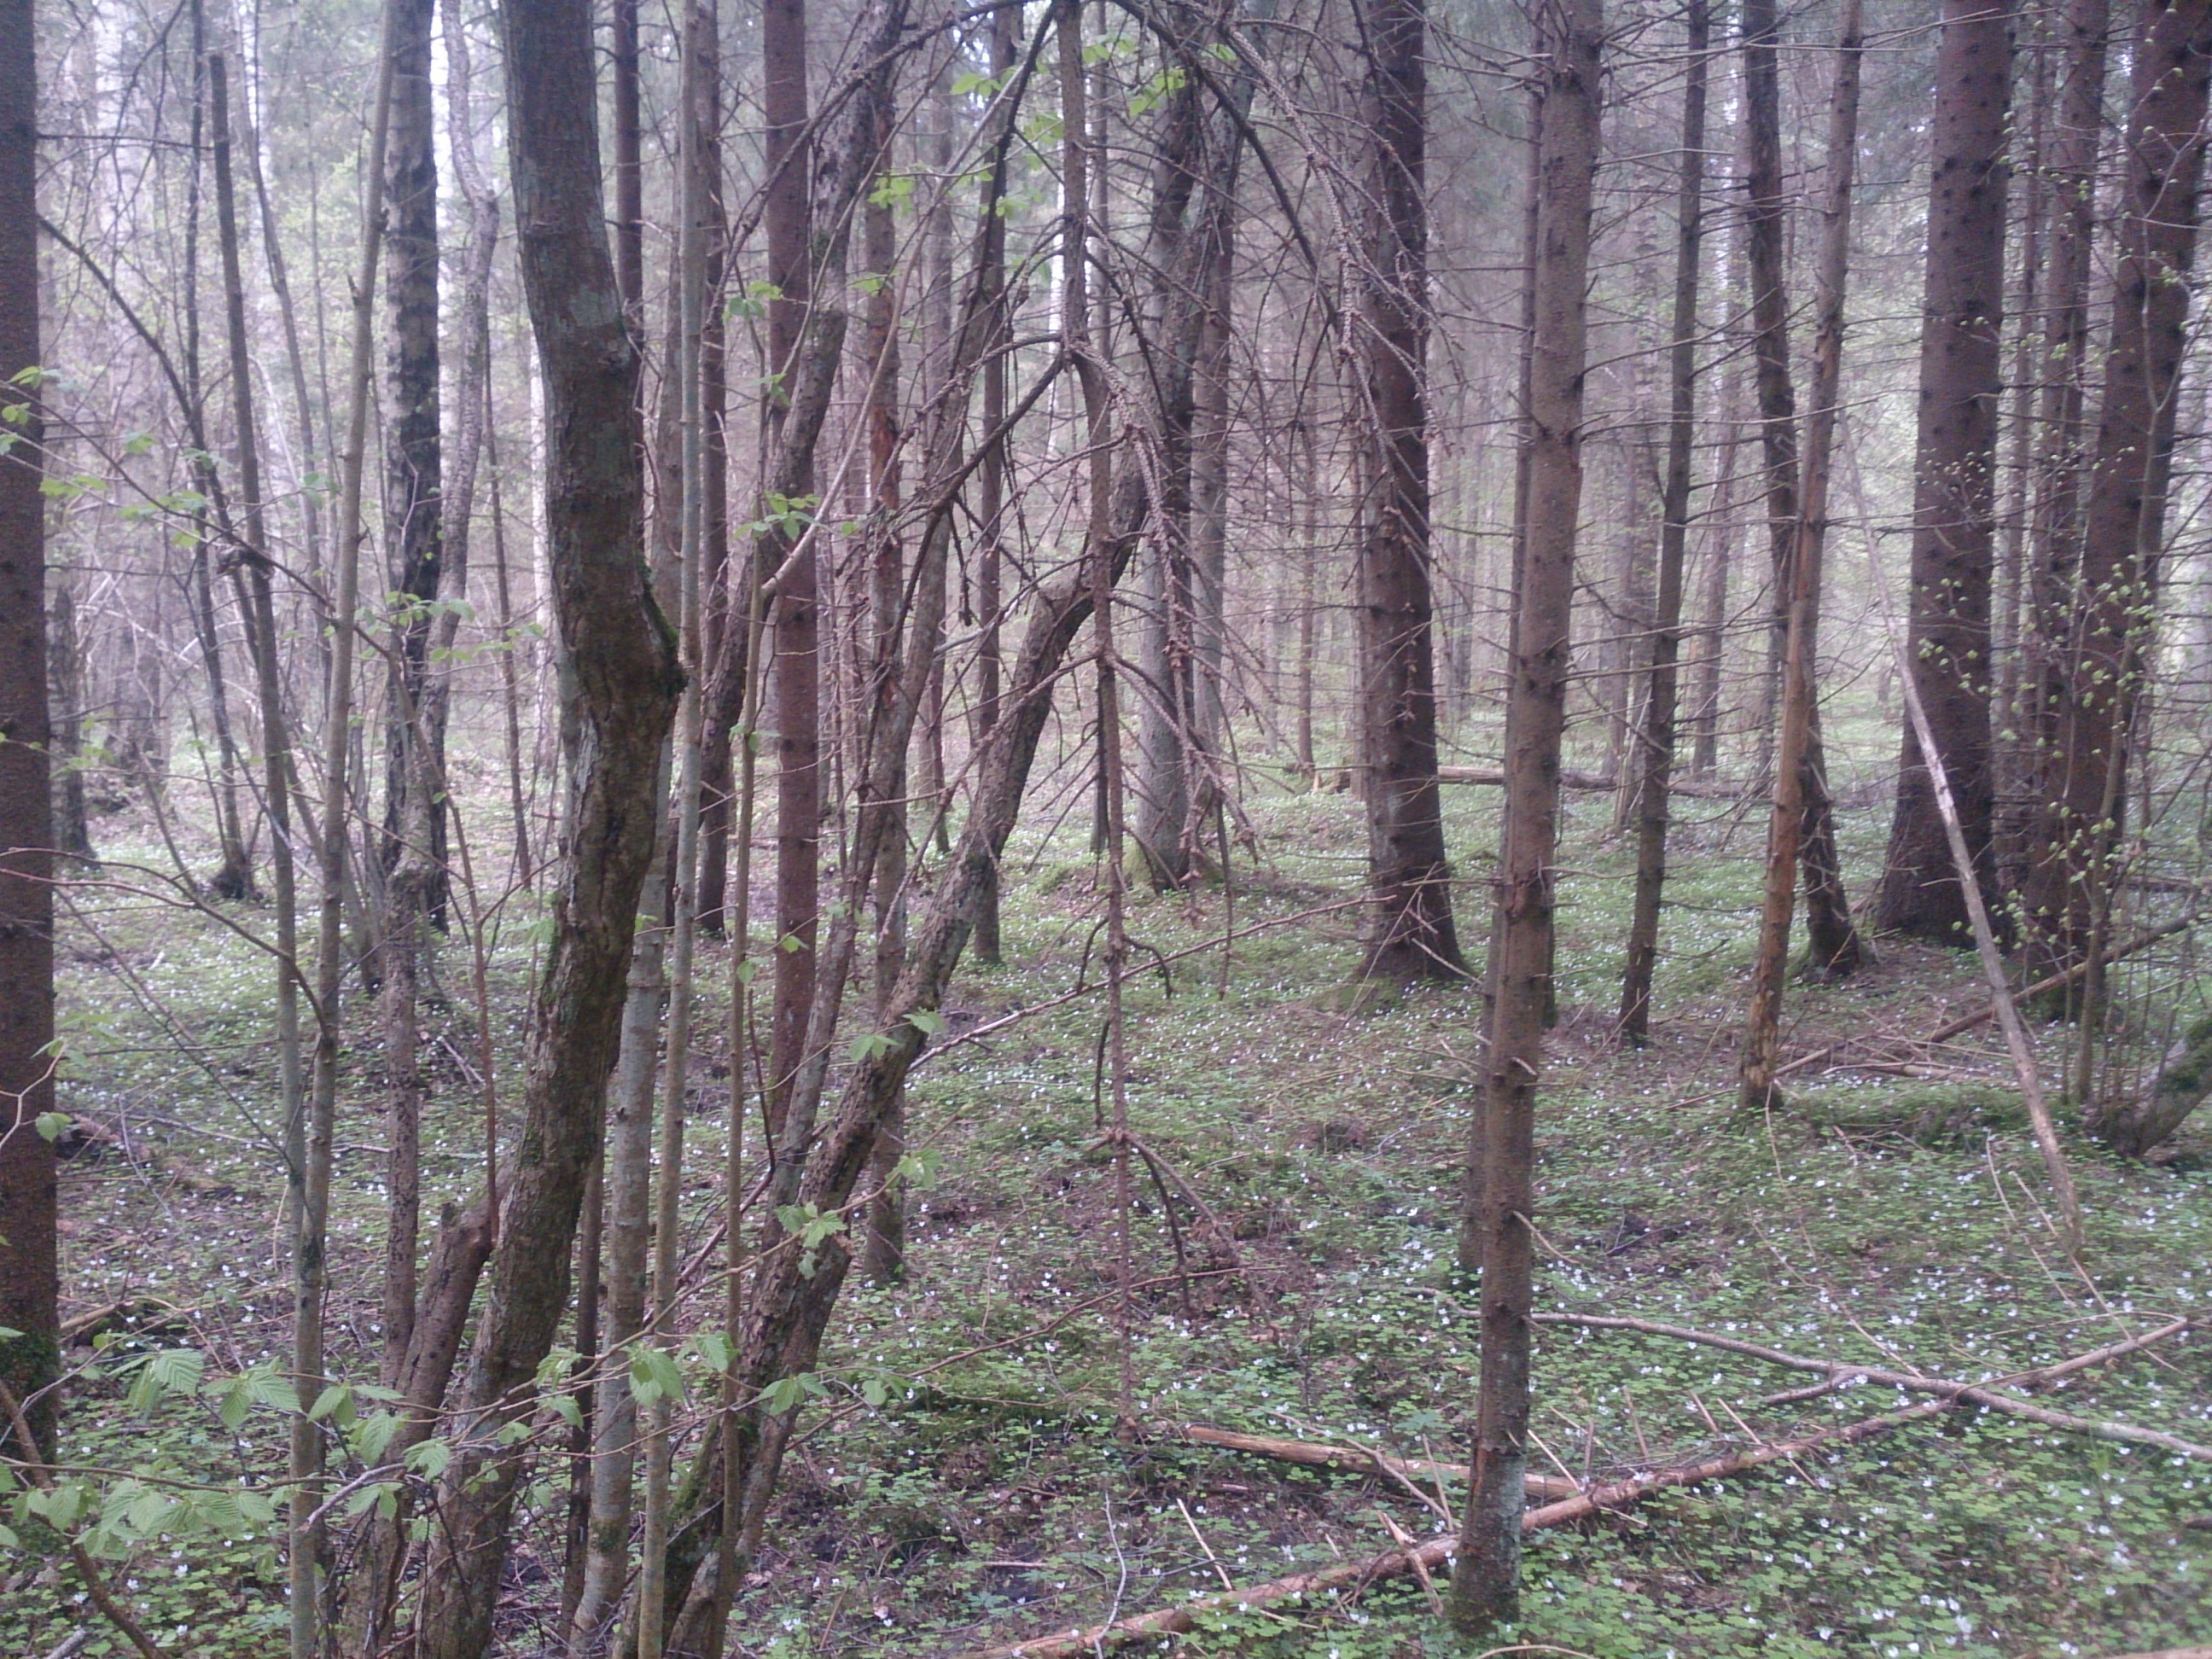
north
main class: Woodland
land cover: Spruce dominated mixed woodland
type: hemiboreal forest and nemoral coniferous forest and mixed broadleaved-coniferous forest
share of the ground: > 75 %
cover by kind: coniferous forest trees 60 %, broadleaved forest trees 40 %
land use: Forestry
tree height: > 5 m
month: May
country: LV
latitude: 56.7111
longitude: 24.0194
